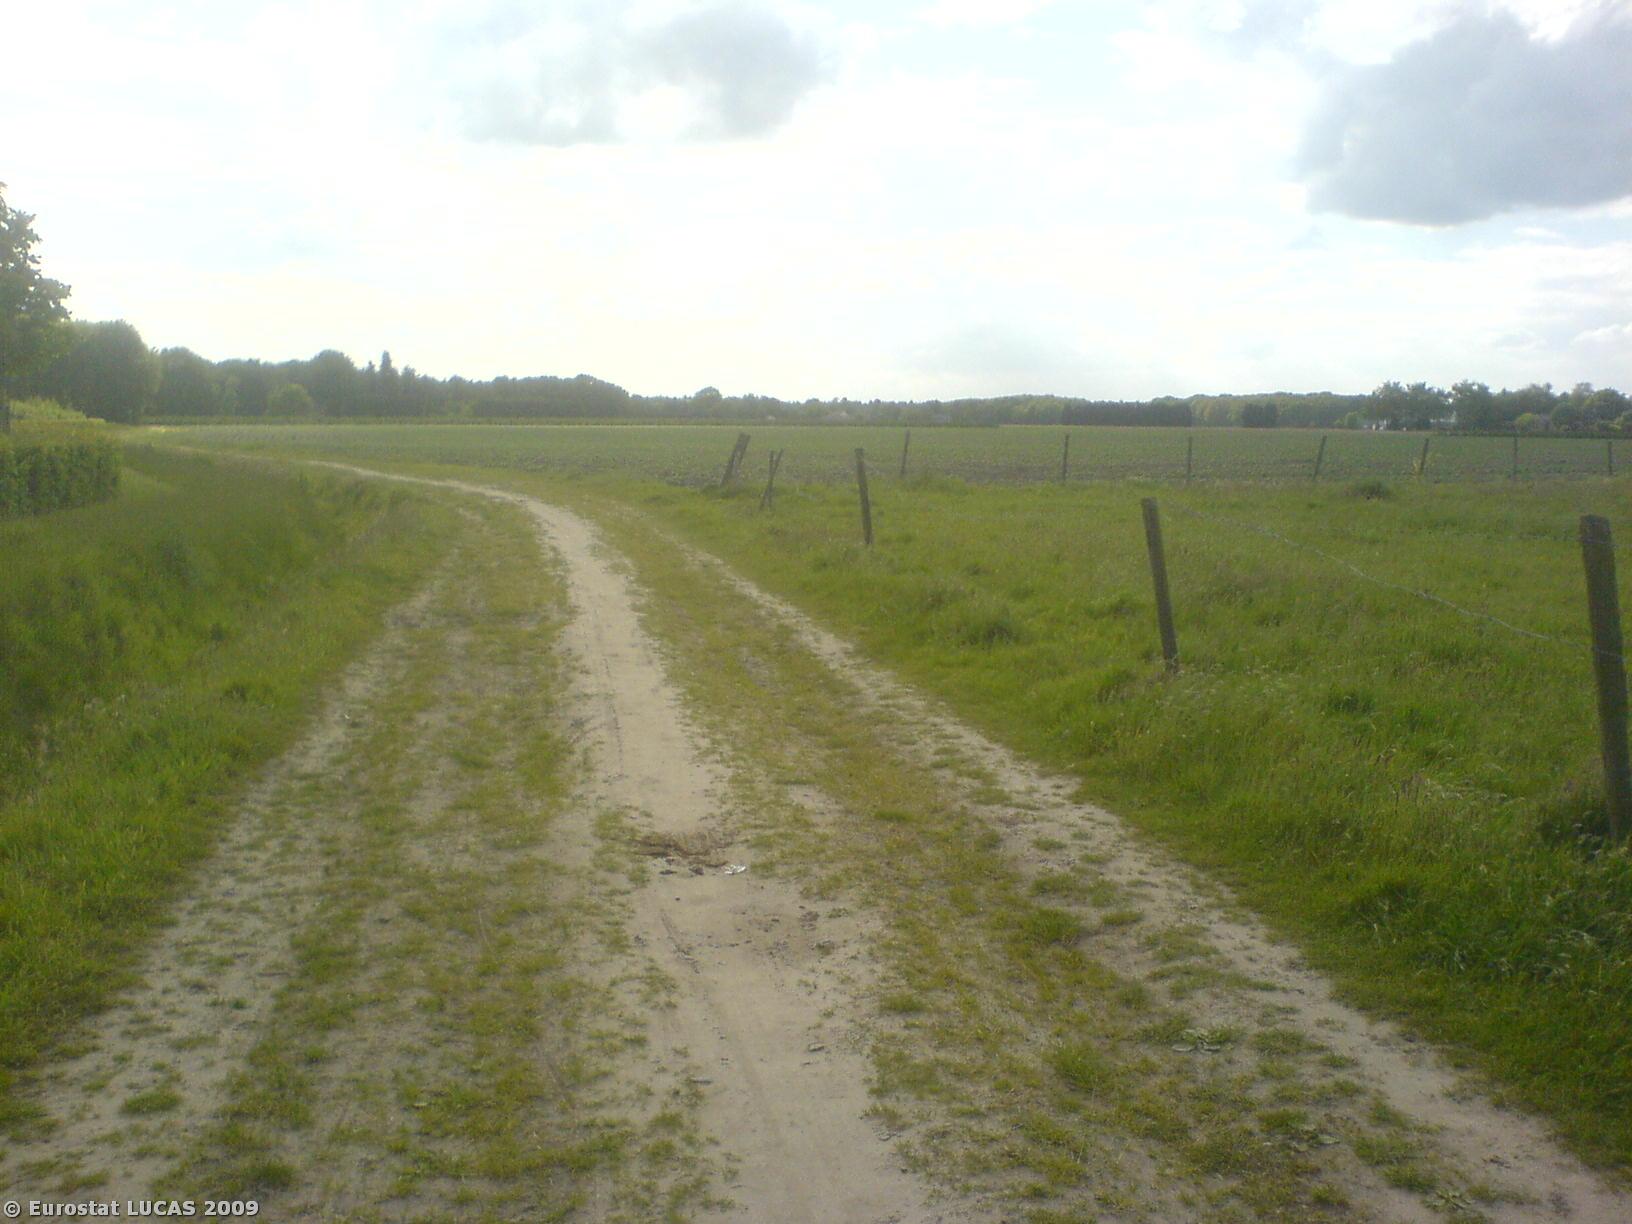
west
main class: Artificial land
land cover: Non built-up linear features
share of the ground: 10 - 25 %
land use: Road transport
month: May
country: NL
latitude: 51.4055
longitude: 5.3833
